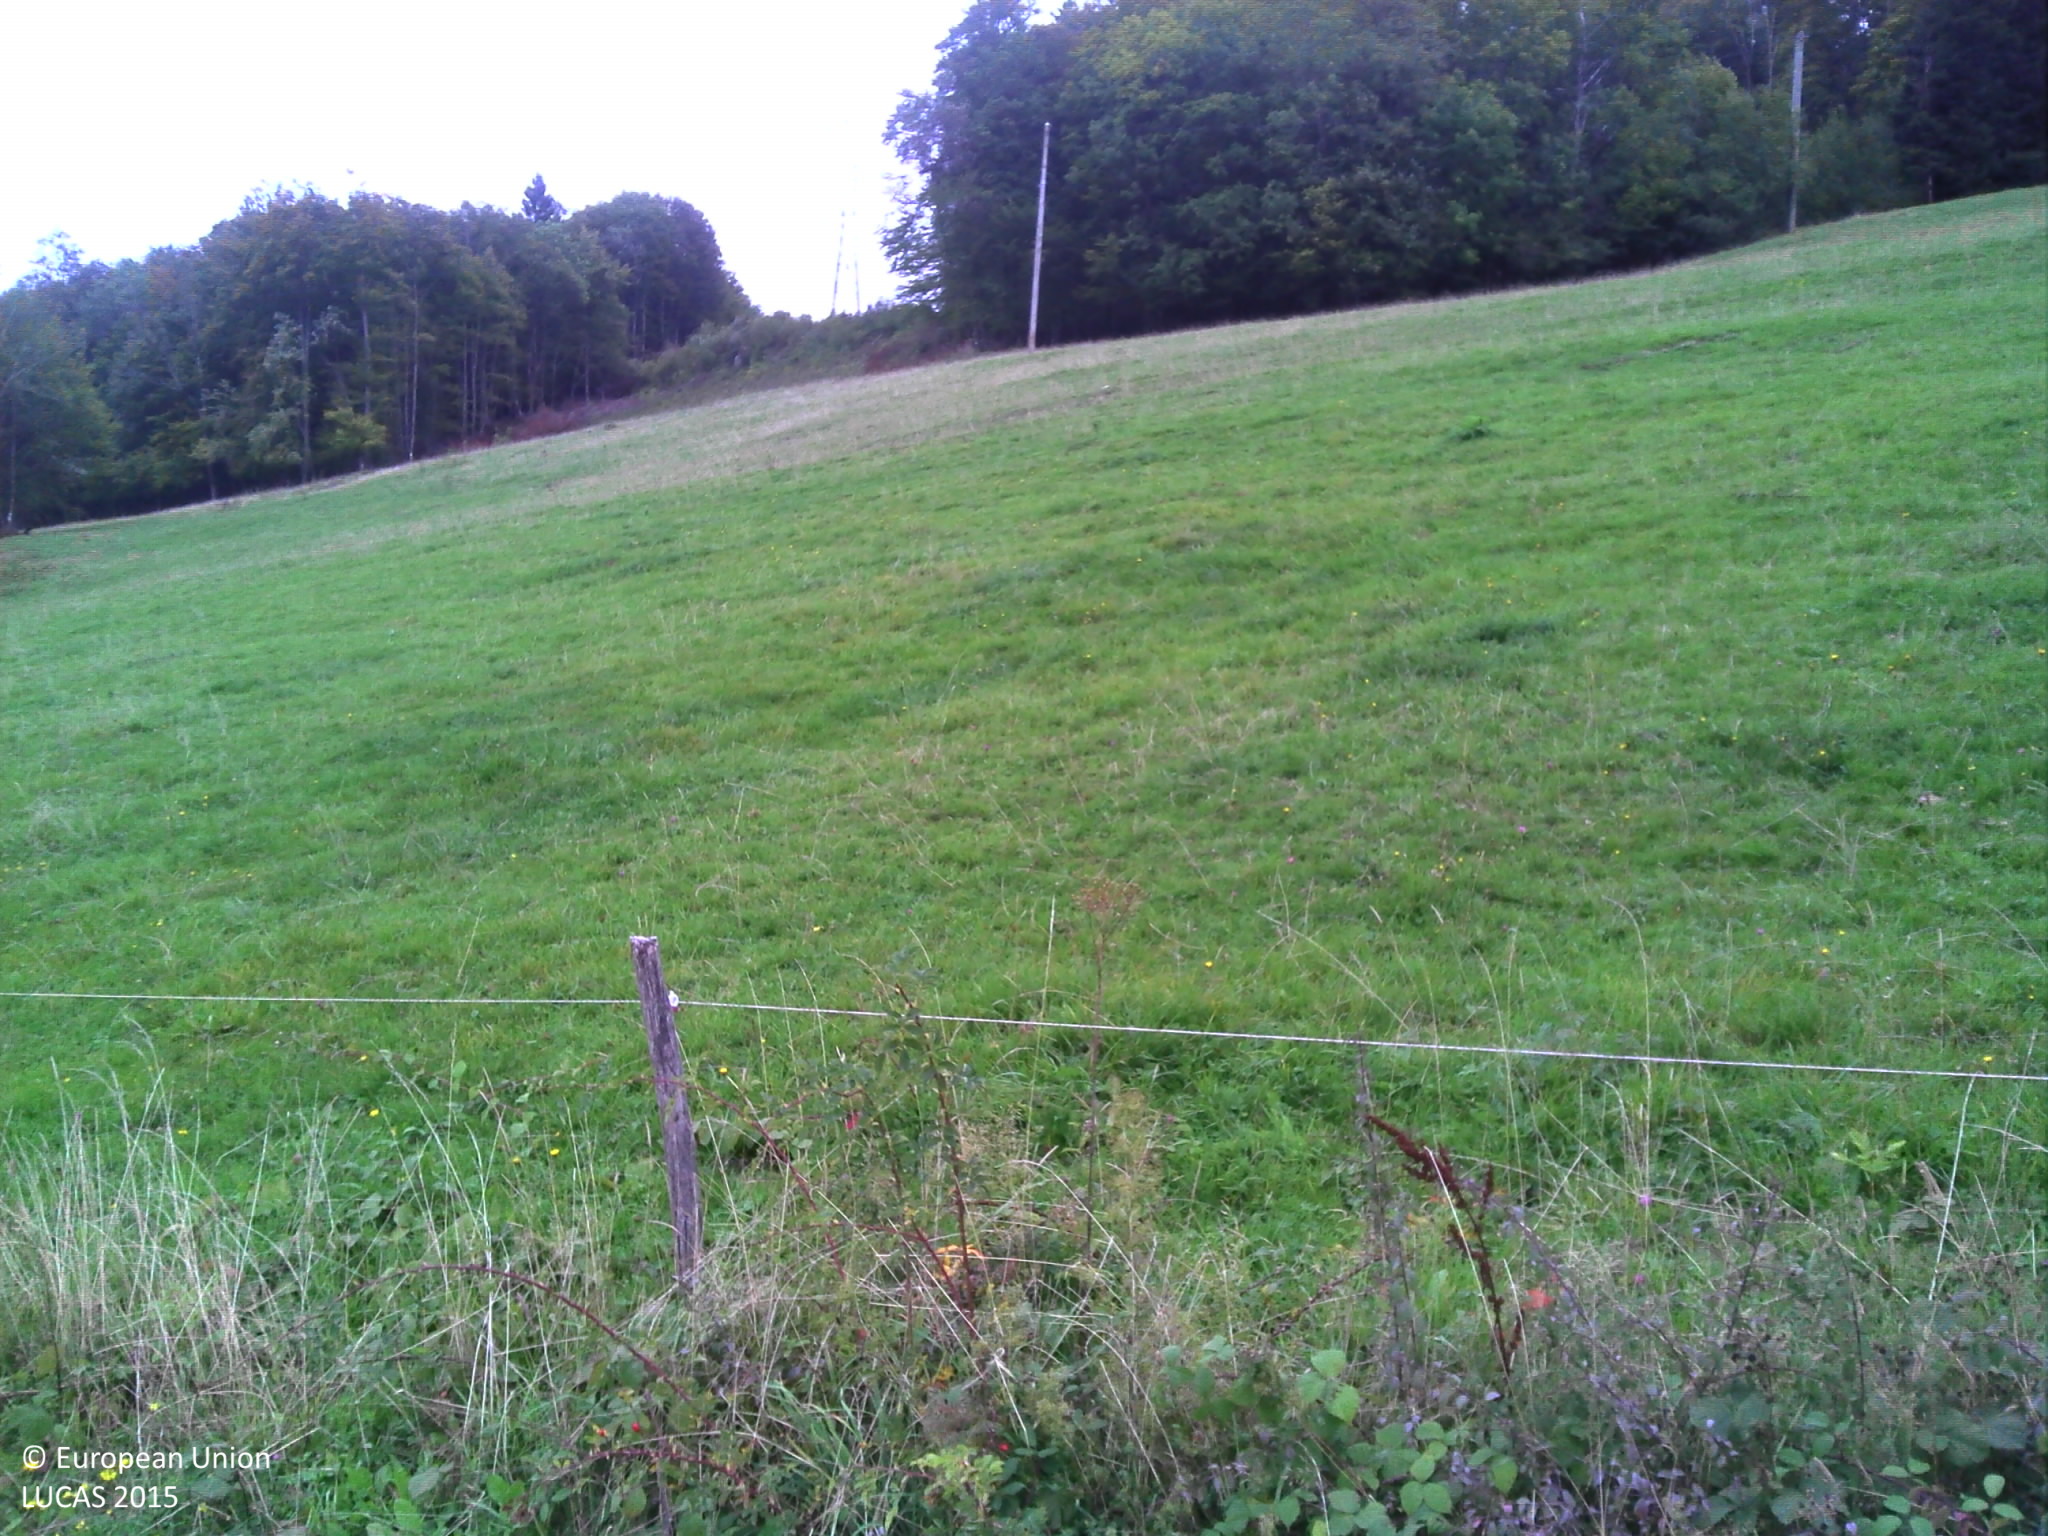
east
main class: Grassland
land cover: Grassland without tree/shrub cover
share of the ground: > 75 %
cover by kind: herbaceous plants 100 %
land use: Agriculture (excluding fallow land and kitchen gardens)
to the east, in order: Shruby margins; Tracks; Grass margins; Fences; Grassland without tree/shrub cover; Electric lines; Broadleaved woodland; Fences; Spontaneously vegetated surfaces; Spruce dominated coniferous woodland; Broadleaved woodland
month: September
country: FR
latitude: 47.3332
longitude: 6.8920
